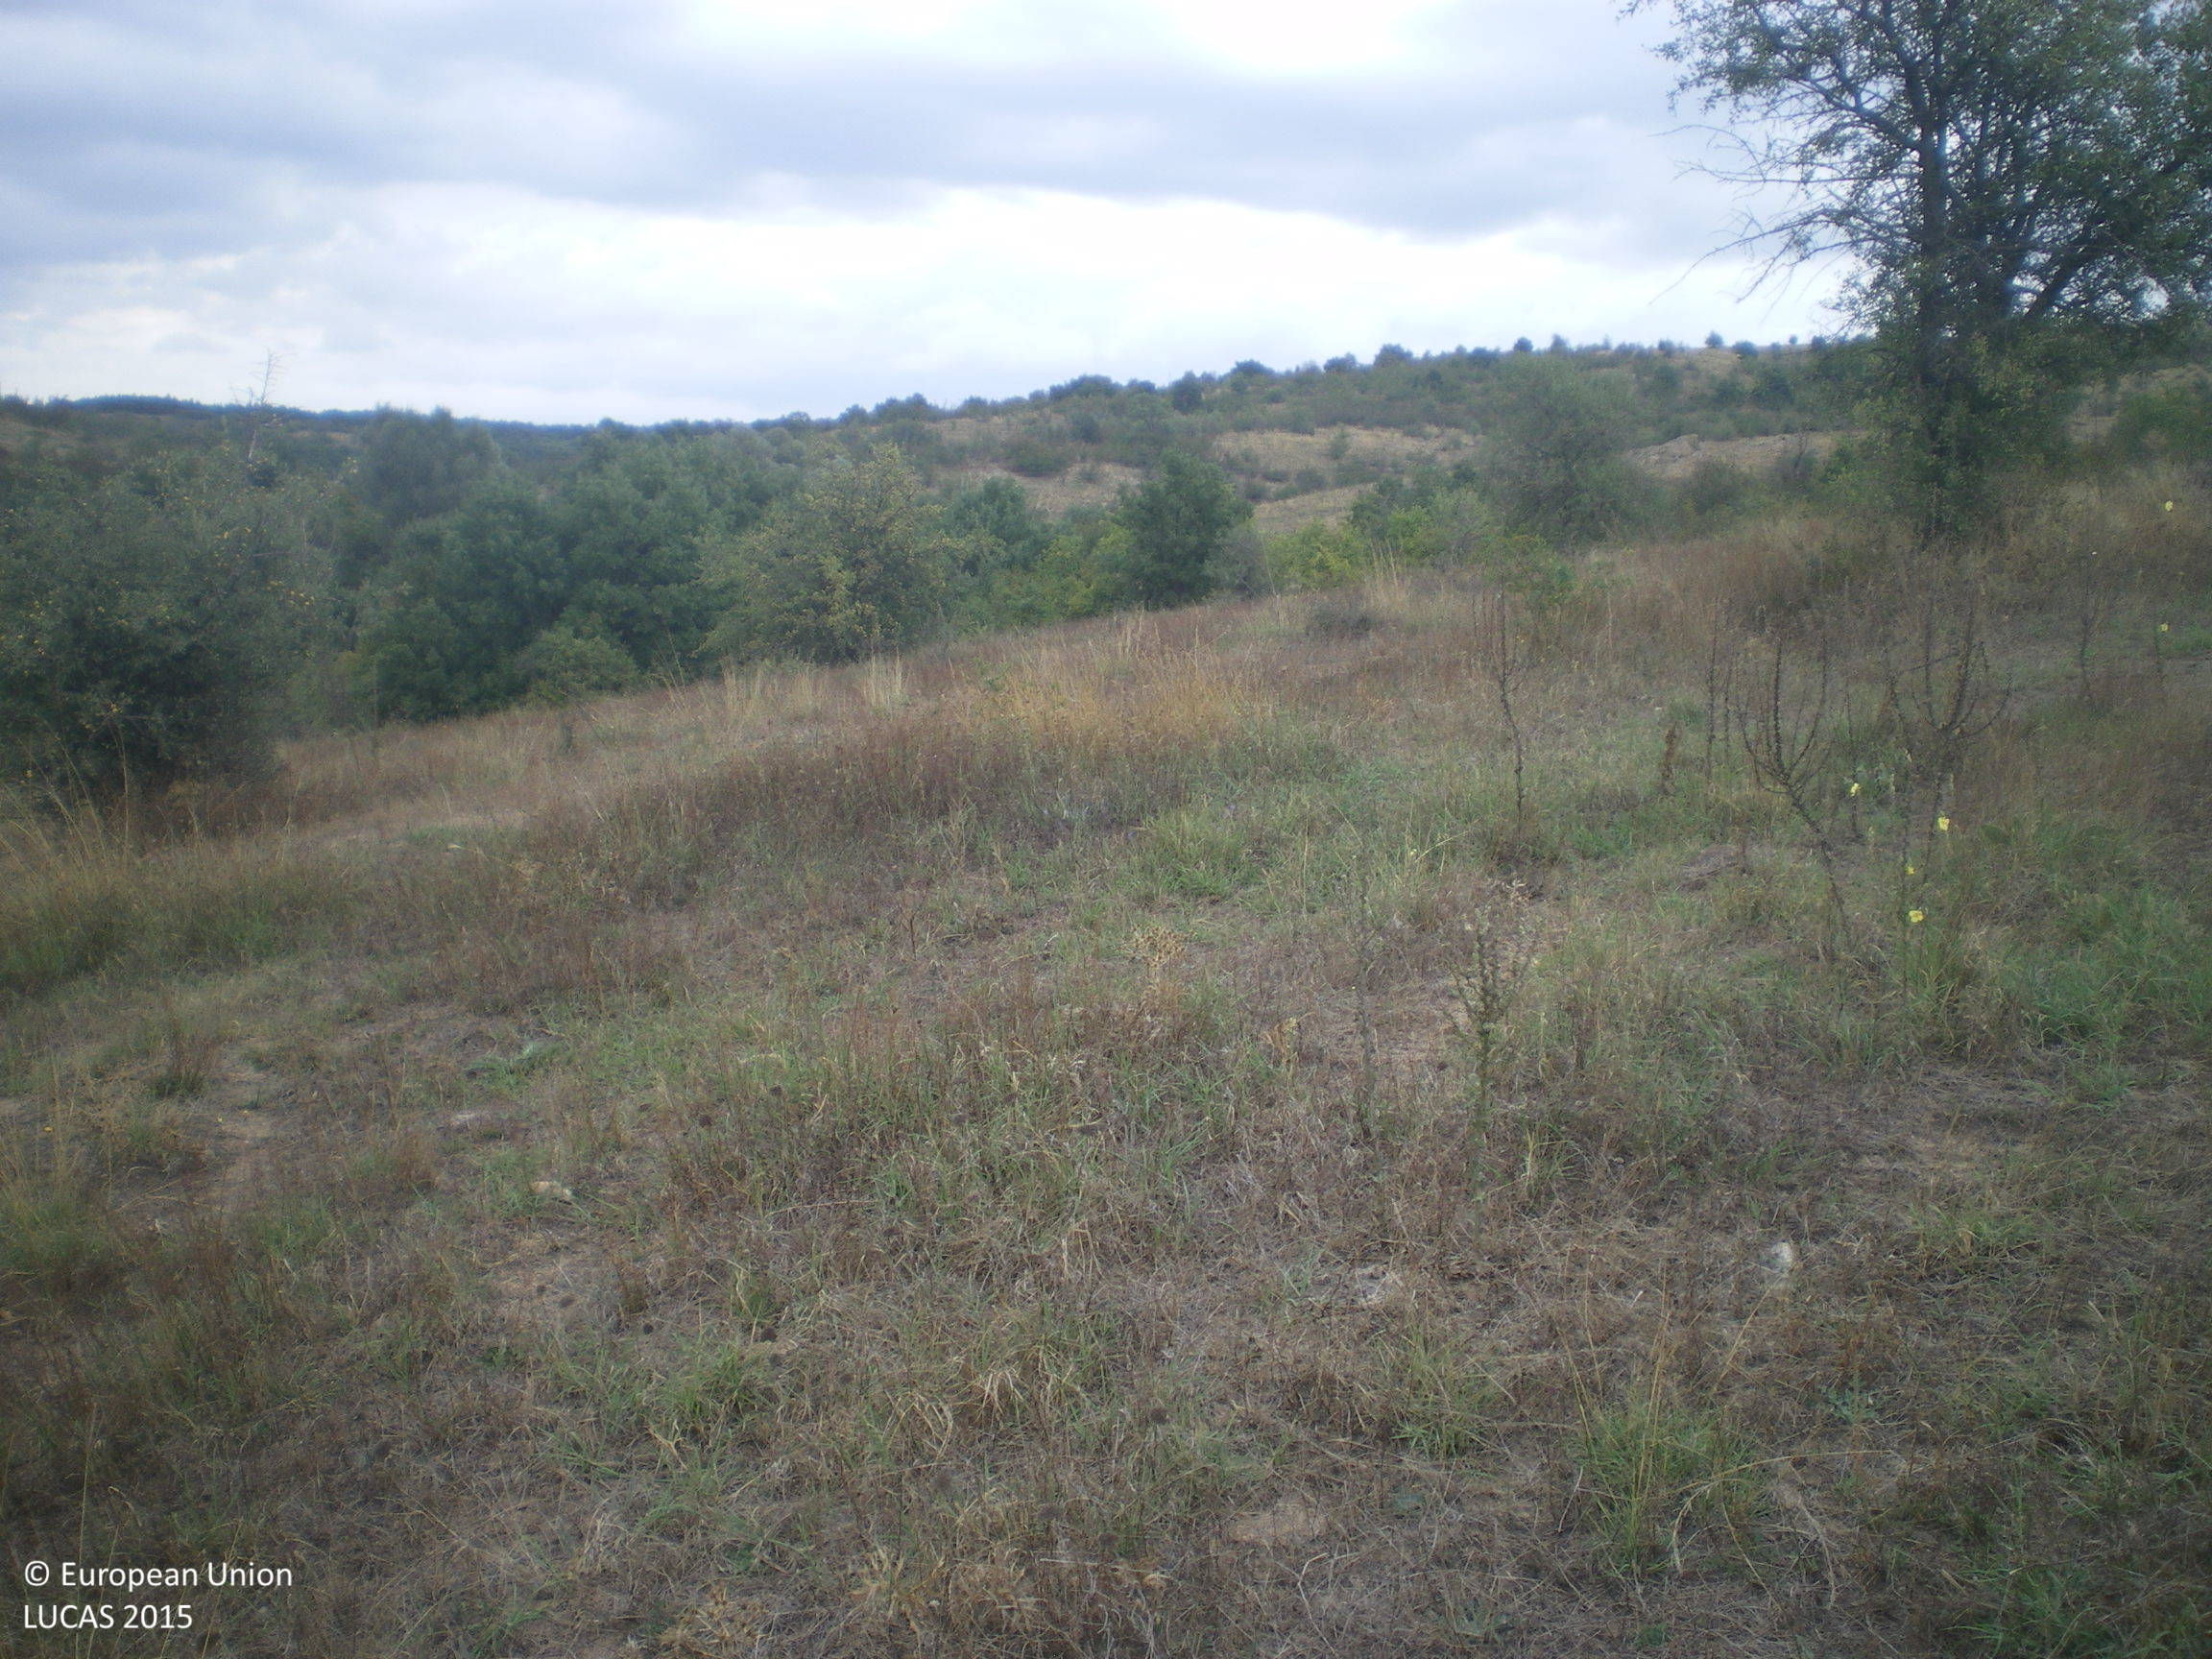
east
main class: Grassland
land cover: Grassland with sparse tree/shrub cover
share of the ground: > 75 %
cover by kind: herbaceous plants 95 %, broadleaved forest trees 5 %
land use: Semi-natural and natural areas not in use
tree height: > 5 m
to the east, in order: Grassland with sparse tree/shrub cover; Shrubland with sparse tree cover; Grassland without tree/shrub cover; Groves; Grassland with sparse tree/shrub cover
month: September
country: BG
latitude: 41.9662
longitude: 25.9647
